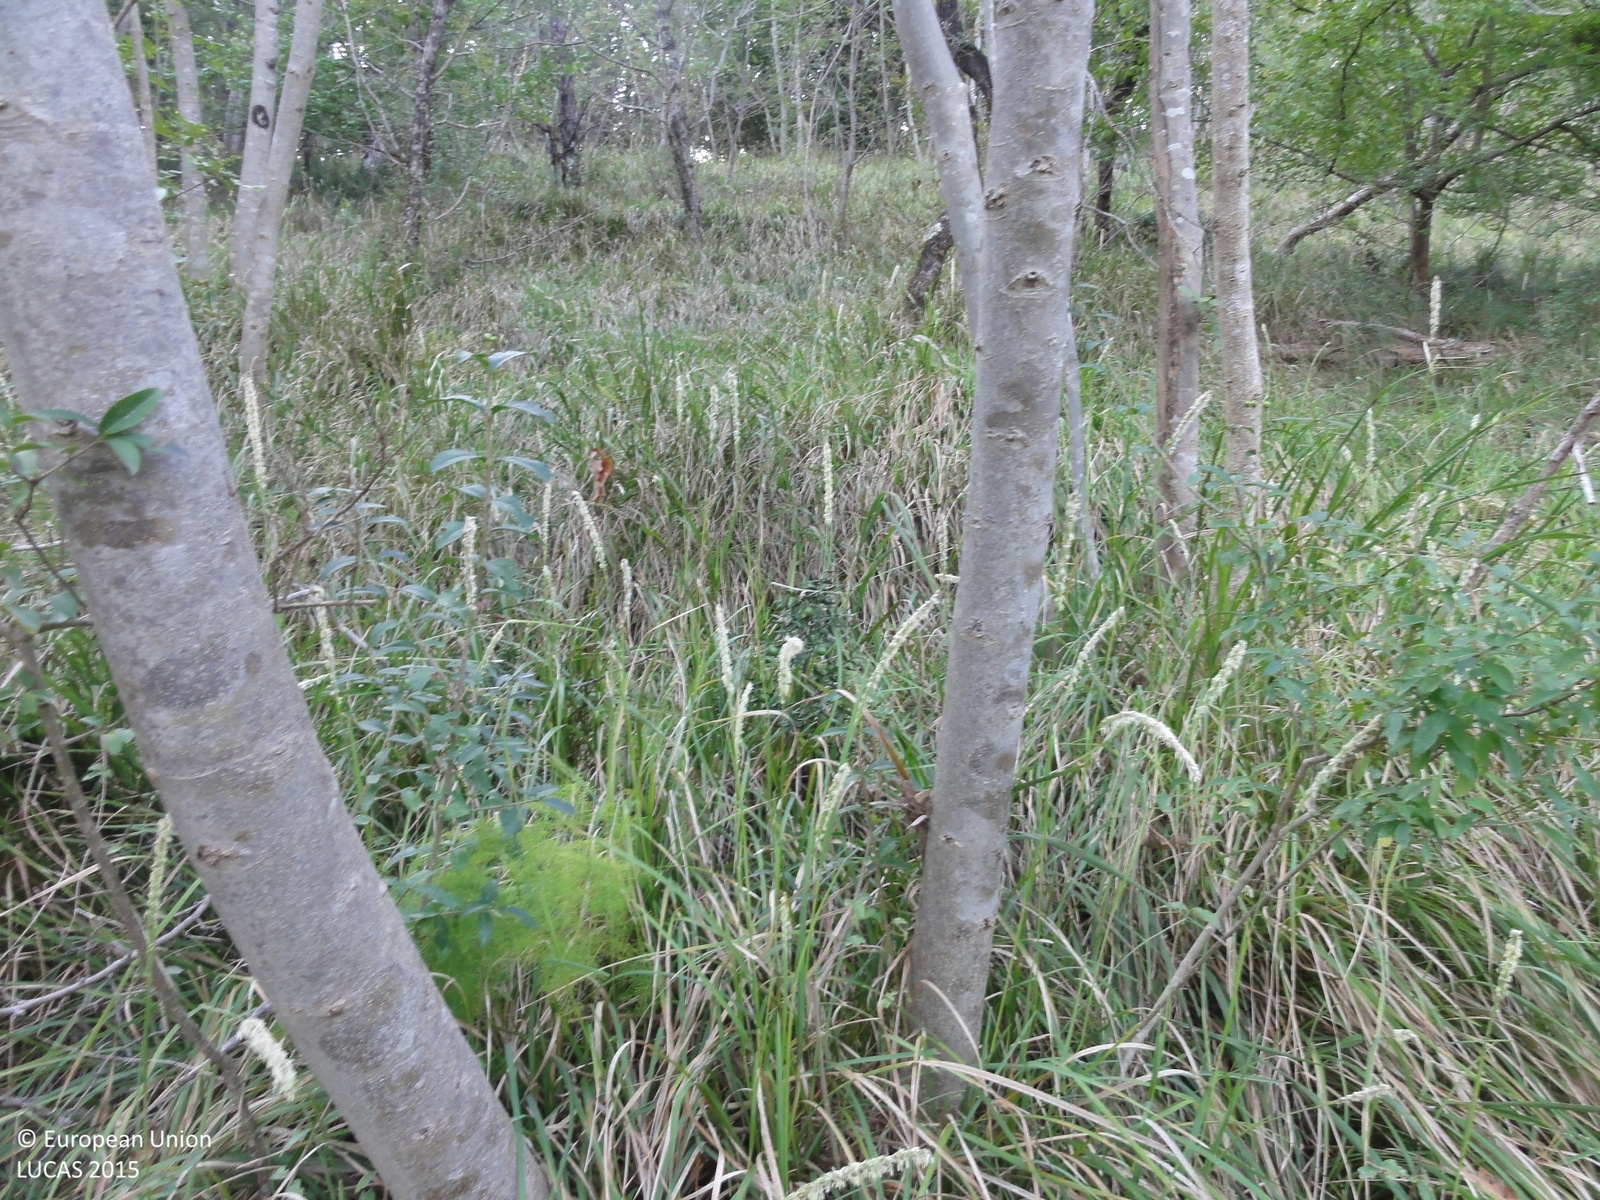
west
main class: Woodland
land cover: Broadleaved woodland
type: thermophilous deciduous forest
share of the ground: > 75 %
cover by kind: broadleaved forest trees 80 %, herbaceous plants 15 %, shrubs 5 %
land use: Semi-natural and natural areas not in use
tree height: > 5 m
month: August
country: SI
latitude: 46.0202
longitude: 13.6001
